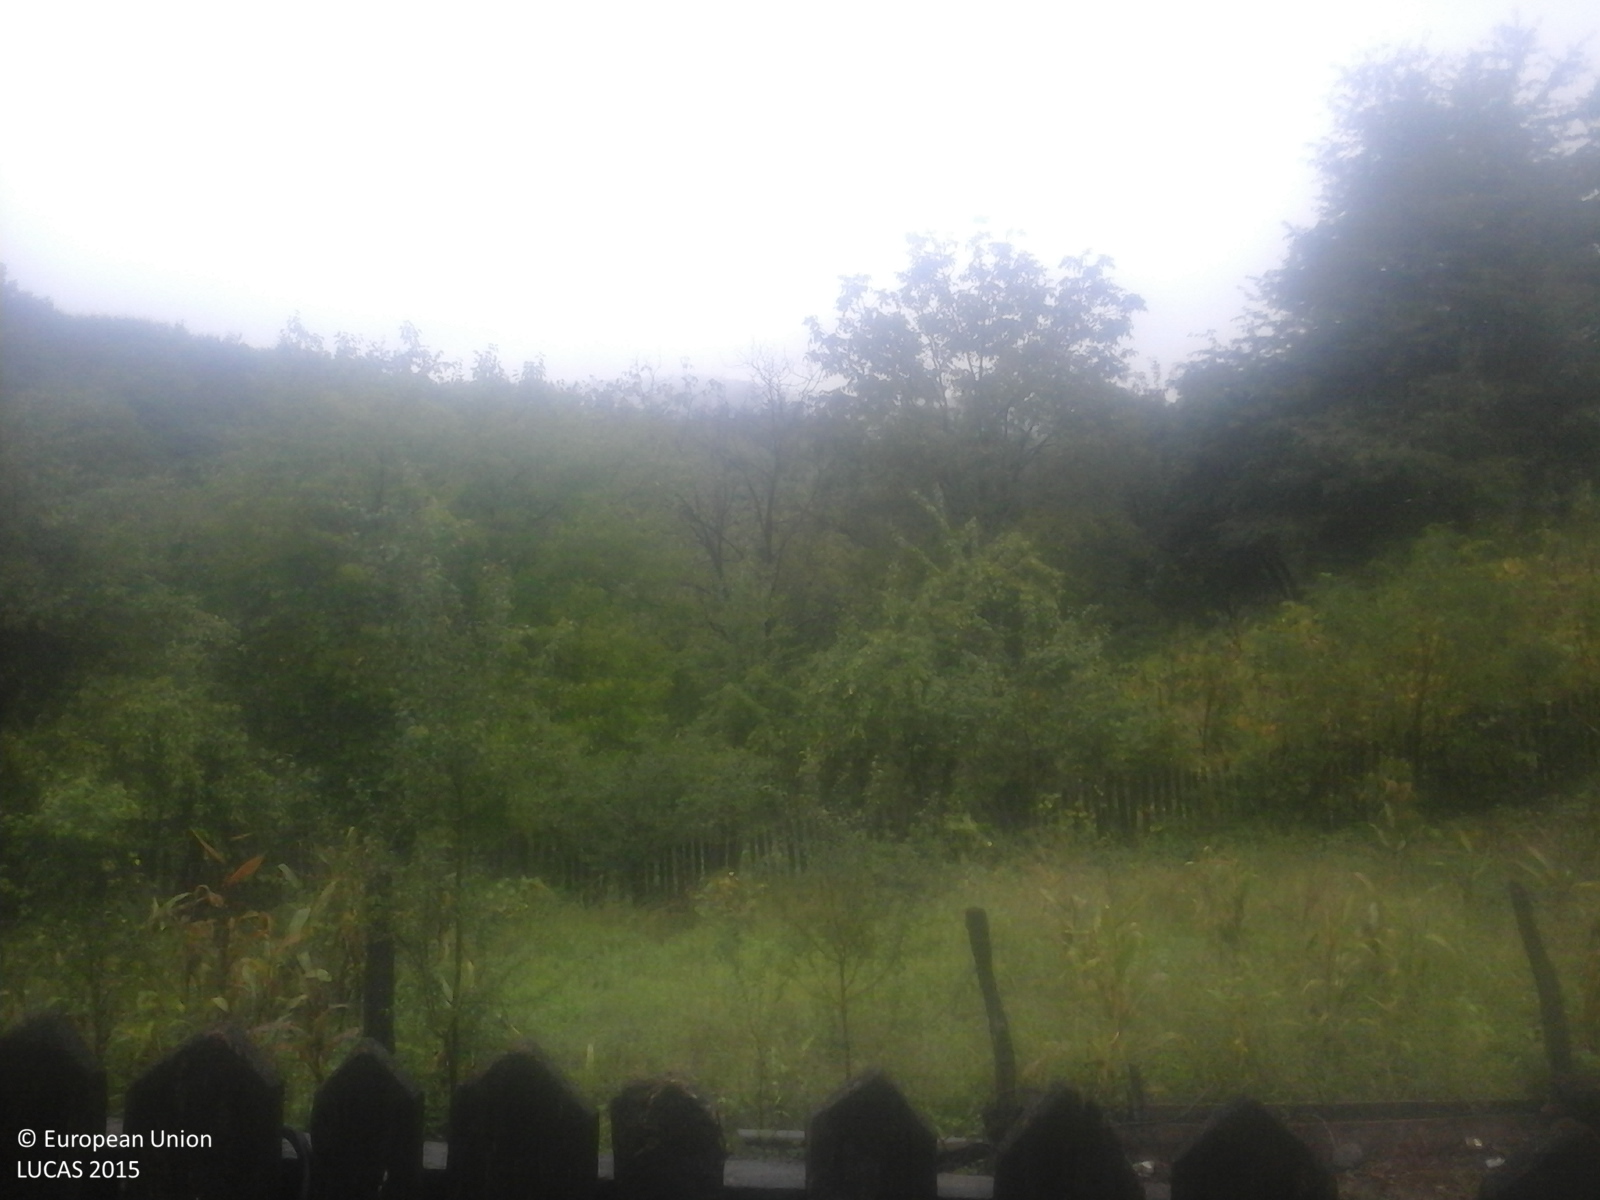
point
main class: Grassland
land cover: Spontaneously vegetated surfaces
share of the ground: > 75 %
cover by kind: herbaceous plants 100 %
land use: Fallow land
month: September
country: RO
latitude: 44.9772
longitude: 23.7955
